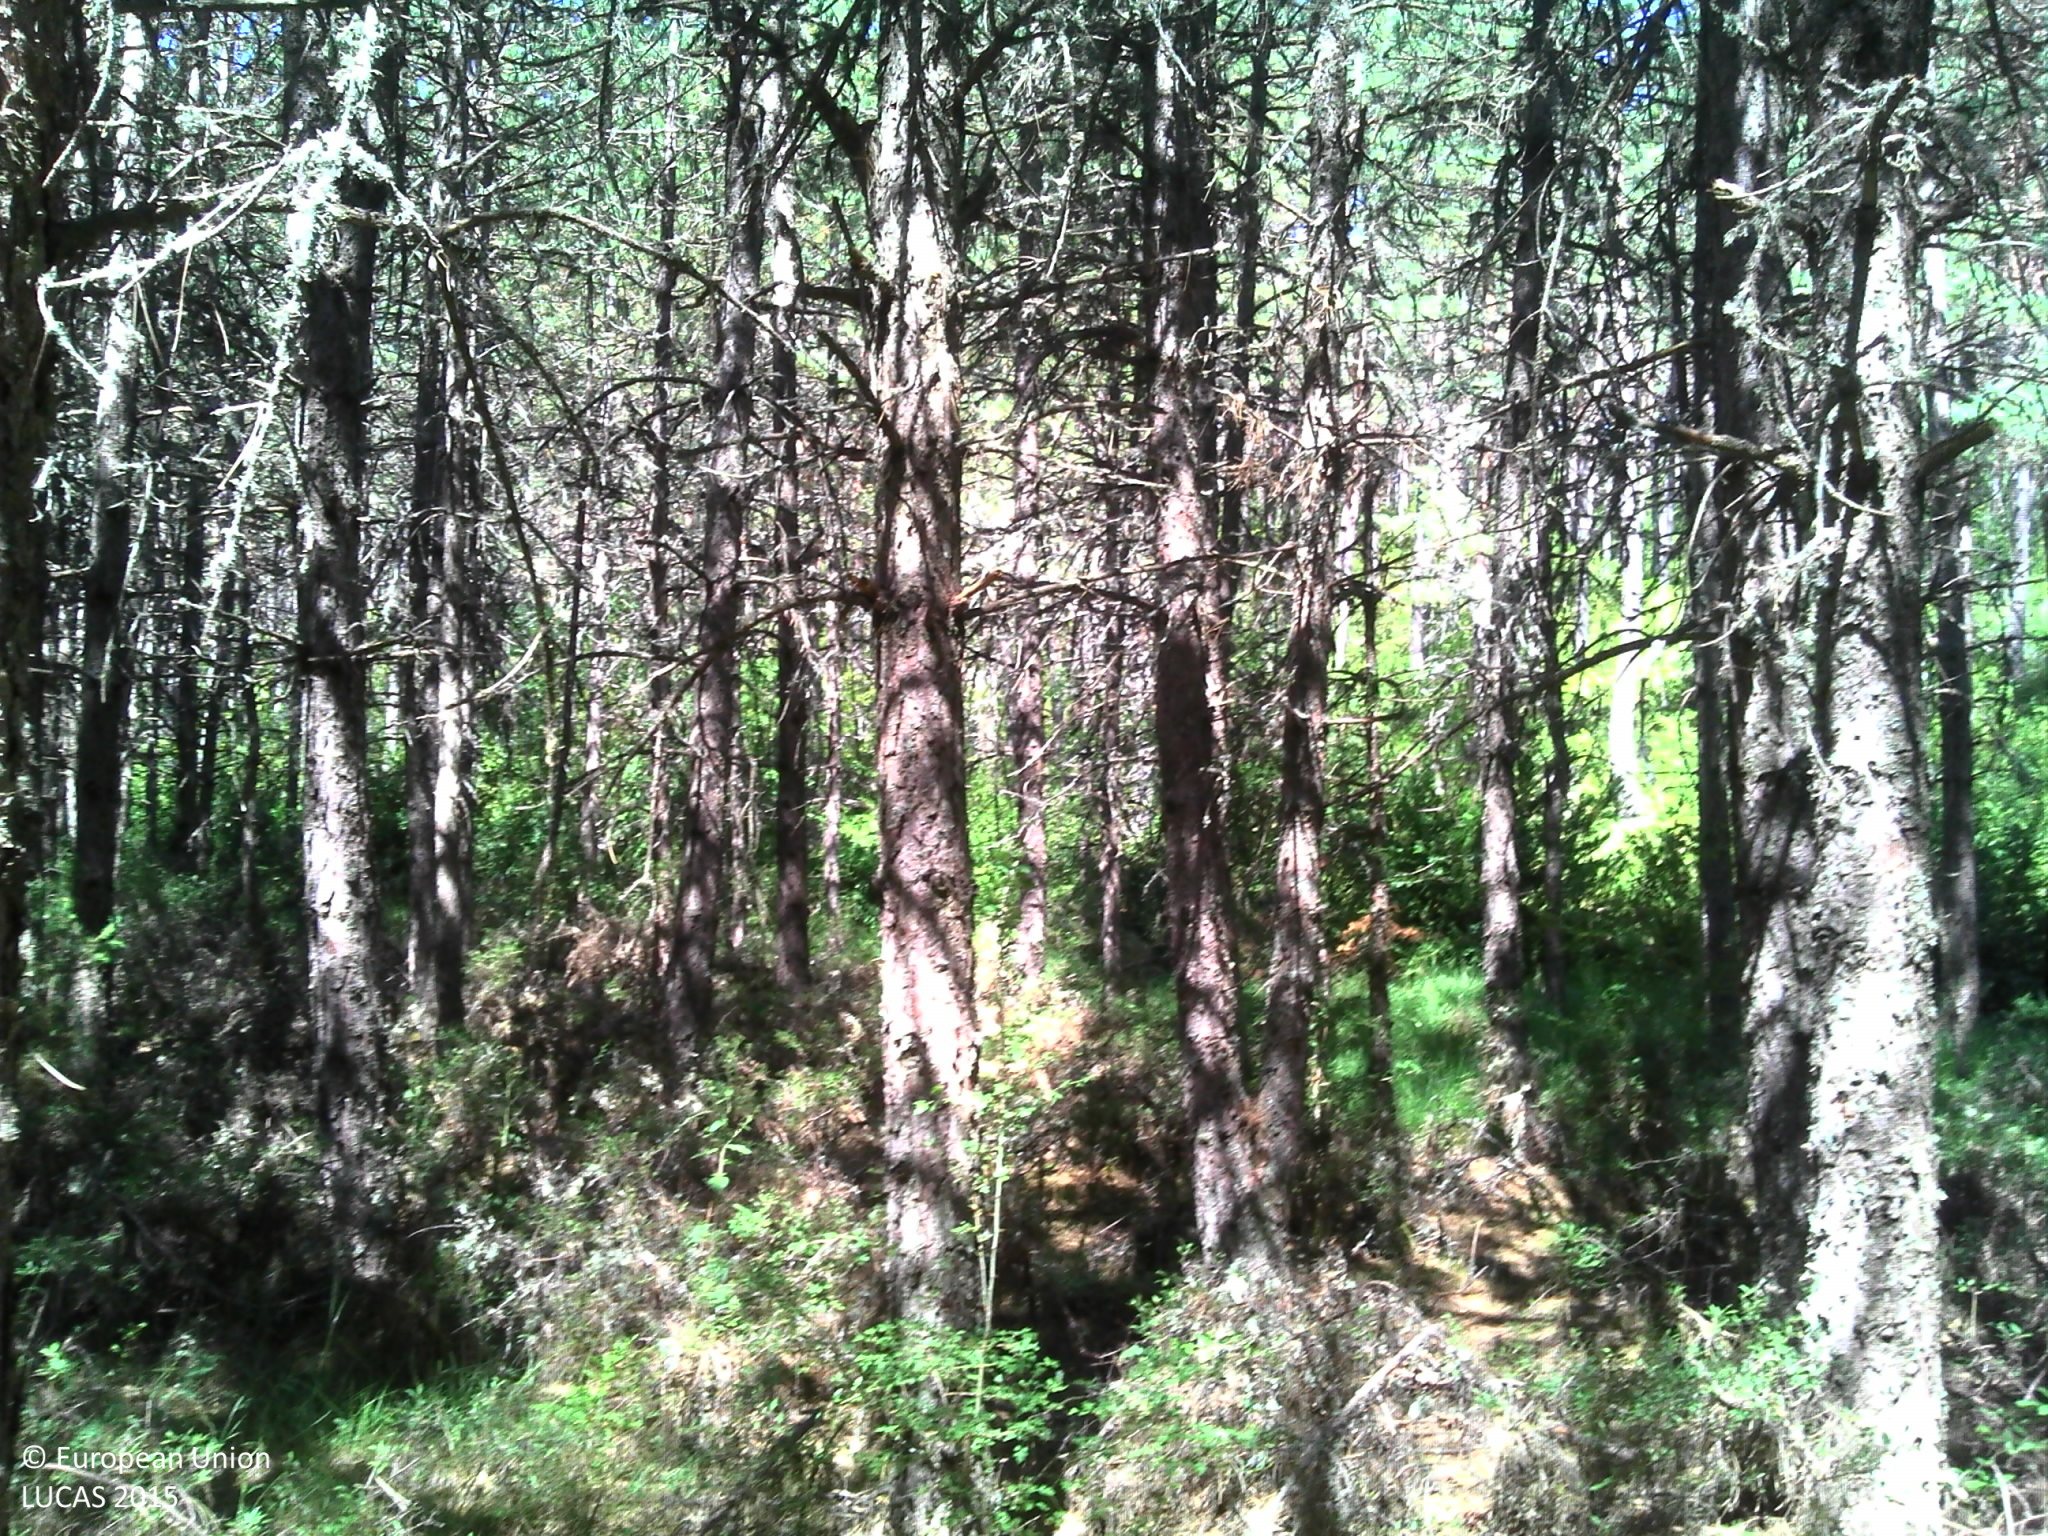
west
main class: Woodland
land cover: Pine dominated coniferous woodland
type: exotic forest
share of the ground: > 75 %
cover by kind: coniferous forest trees 85 %, broadleaved forest trees 5 %, shrubs 5 %, herbaceous plants 5 %
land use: Forestry
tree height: > 5 m
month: July
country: FR
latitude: 44.3637
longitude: 3.2168
